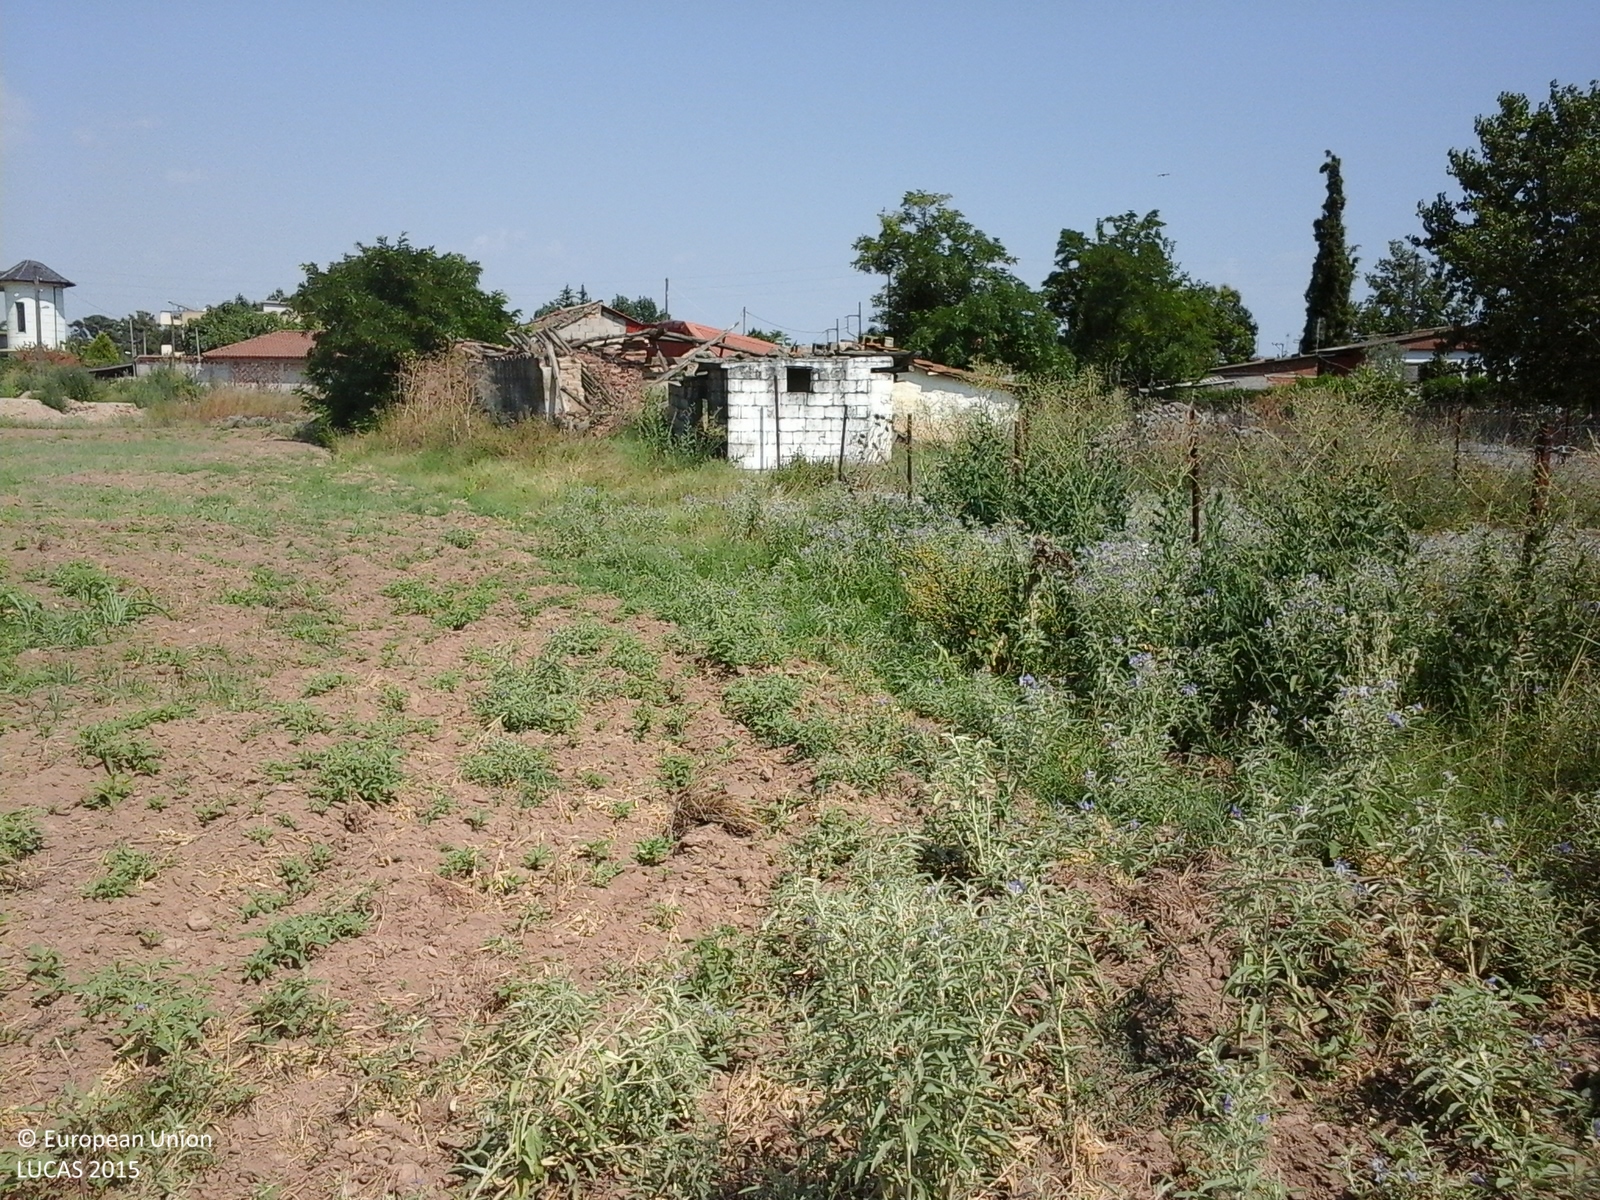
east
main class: Grassland
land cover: Spontaneously vegetated surfaces
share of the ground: > 75 %
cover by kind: herbaceous plants 100 %
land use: Fallow land
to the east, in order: Spontaneously vegetated surfaces; Artificial constructions in urban areas
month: July
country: GR
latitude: 40.7204
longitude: 22.6843
